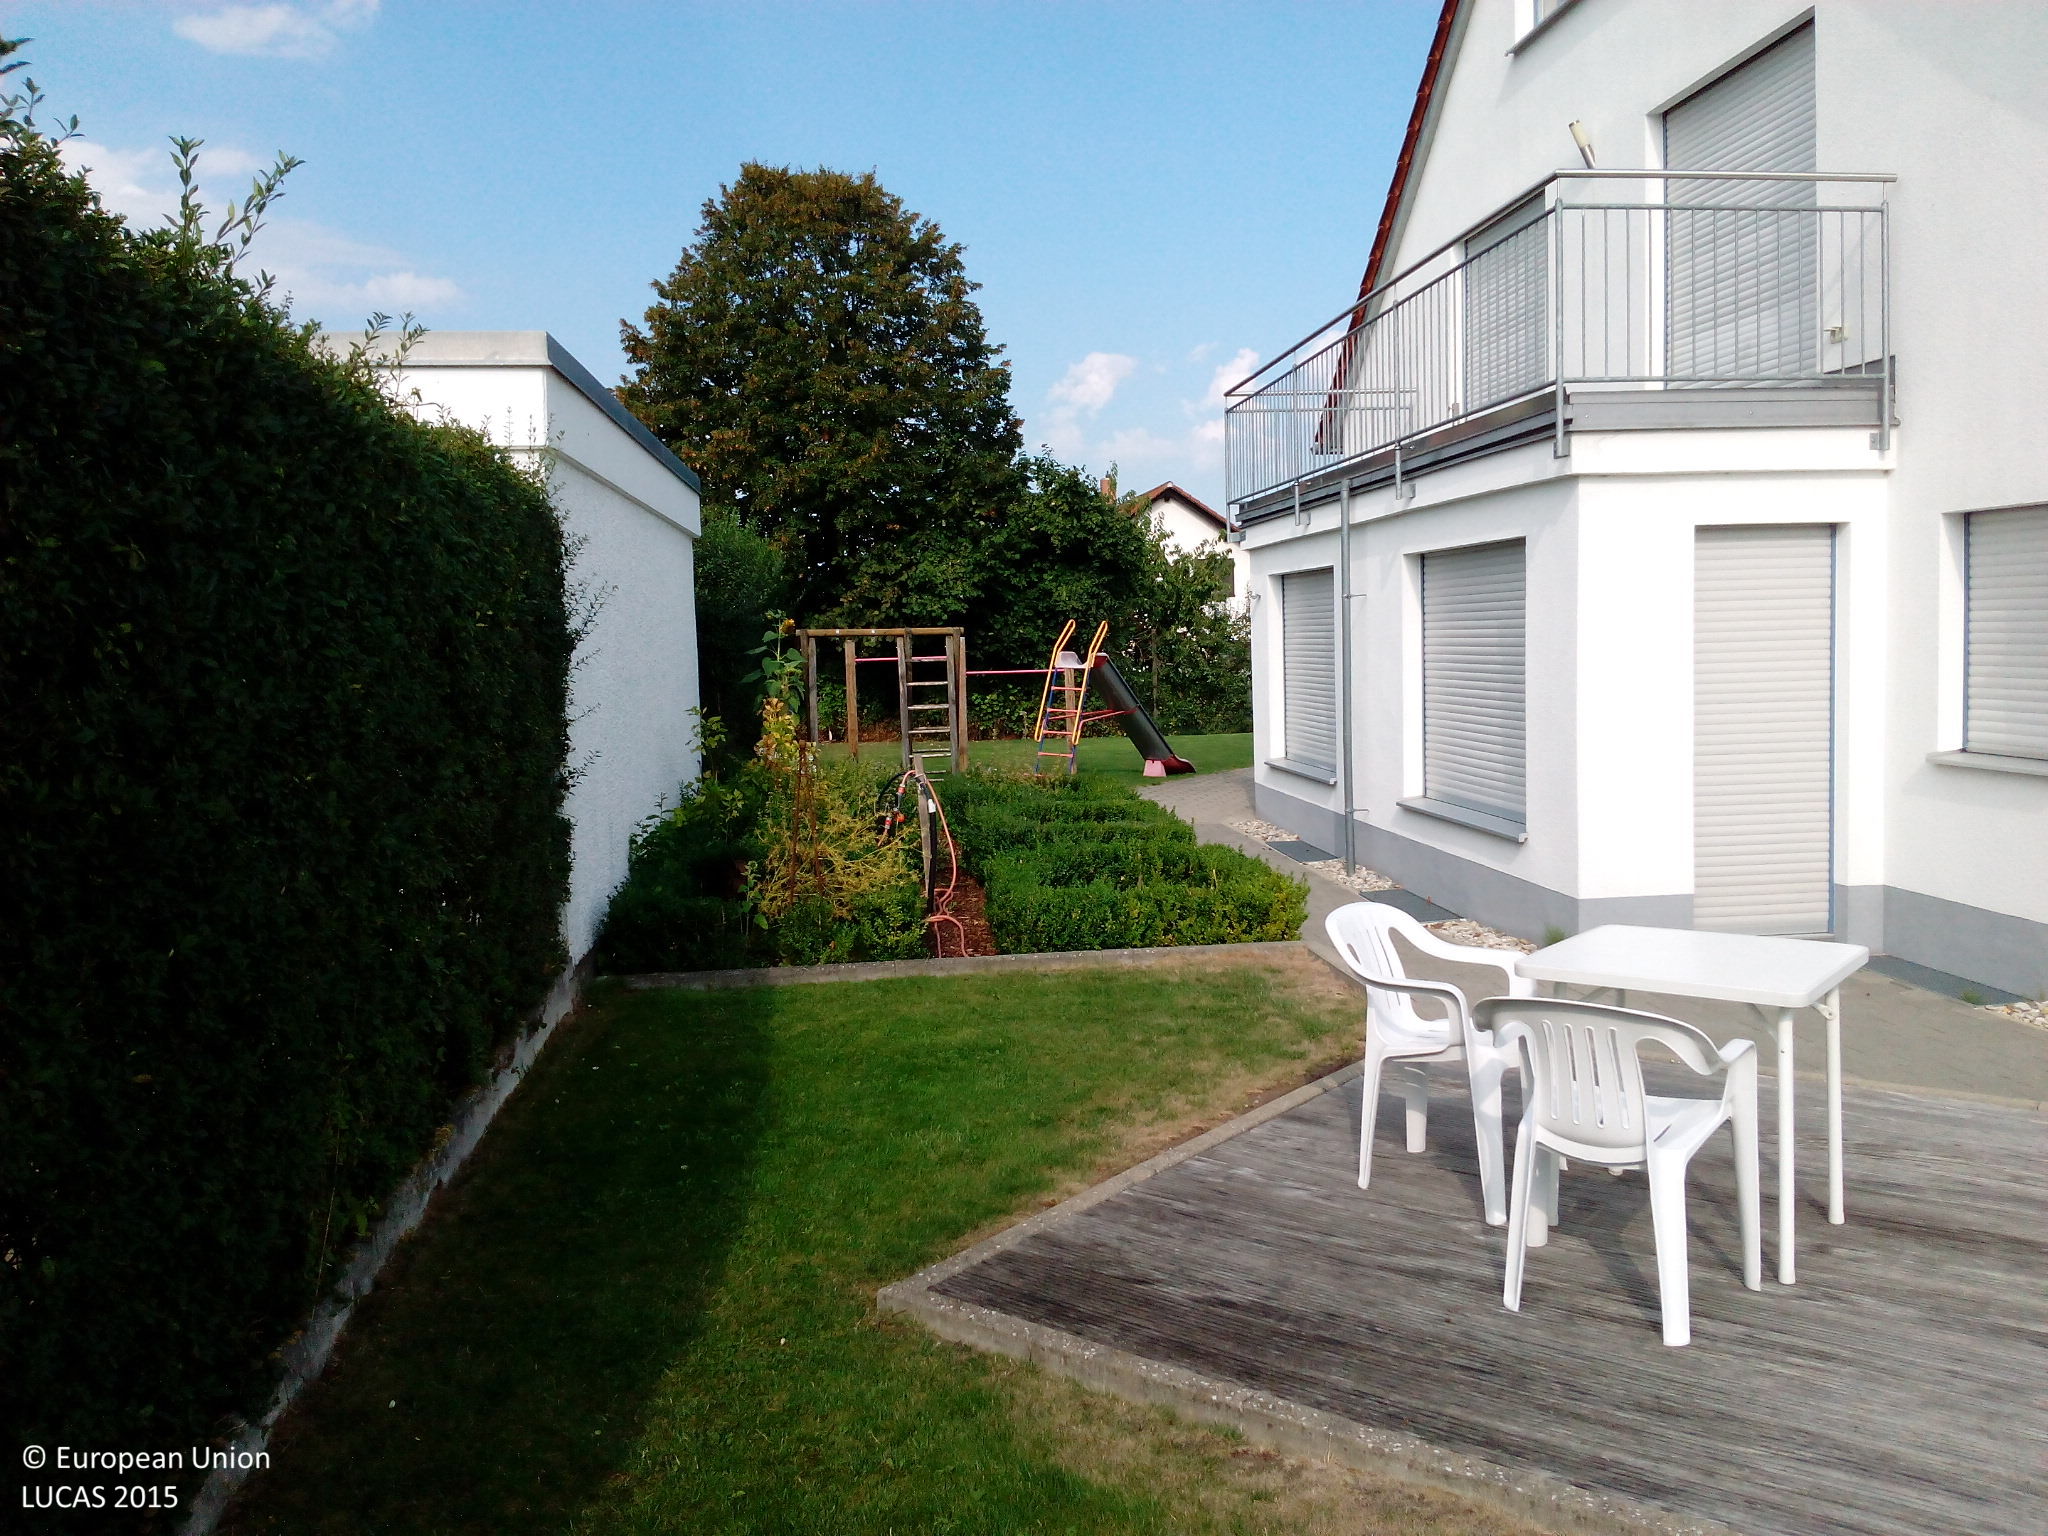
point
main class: Grassland
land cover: Grassland without tree/shrub cover
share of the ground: > 75 %
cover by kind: herbaceous plants 100 %
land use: Residential
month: August
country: DE
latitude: 48.4570
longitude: 10.3108
